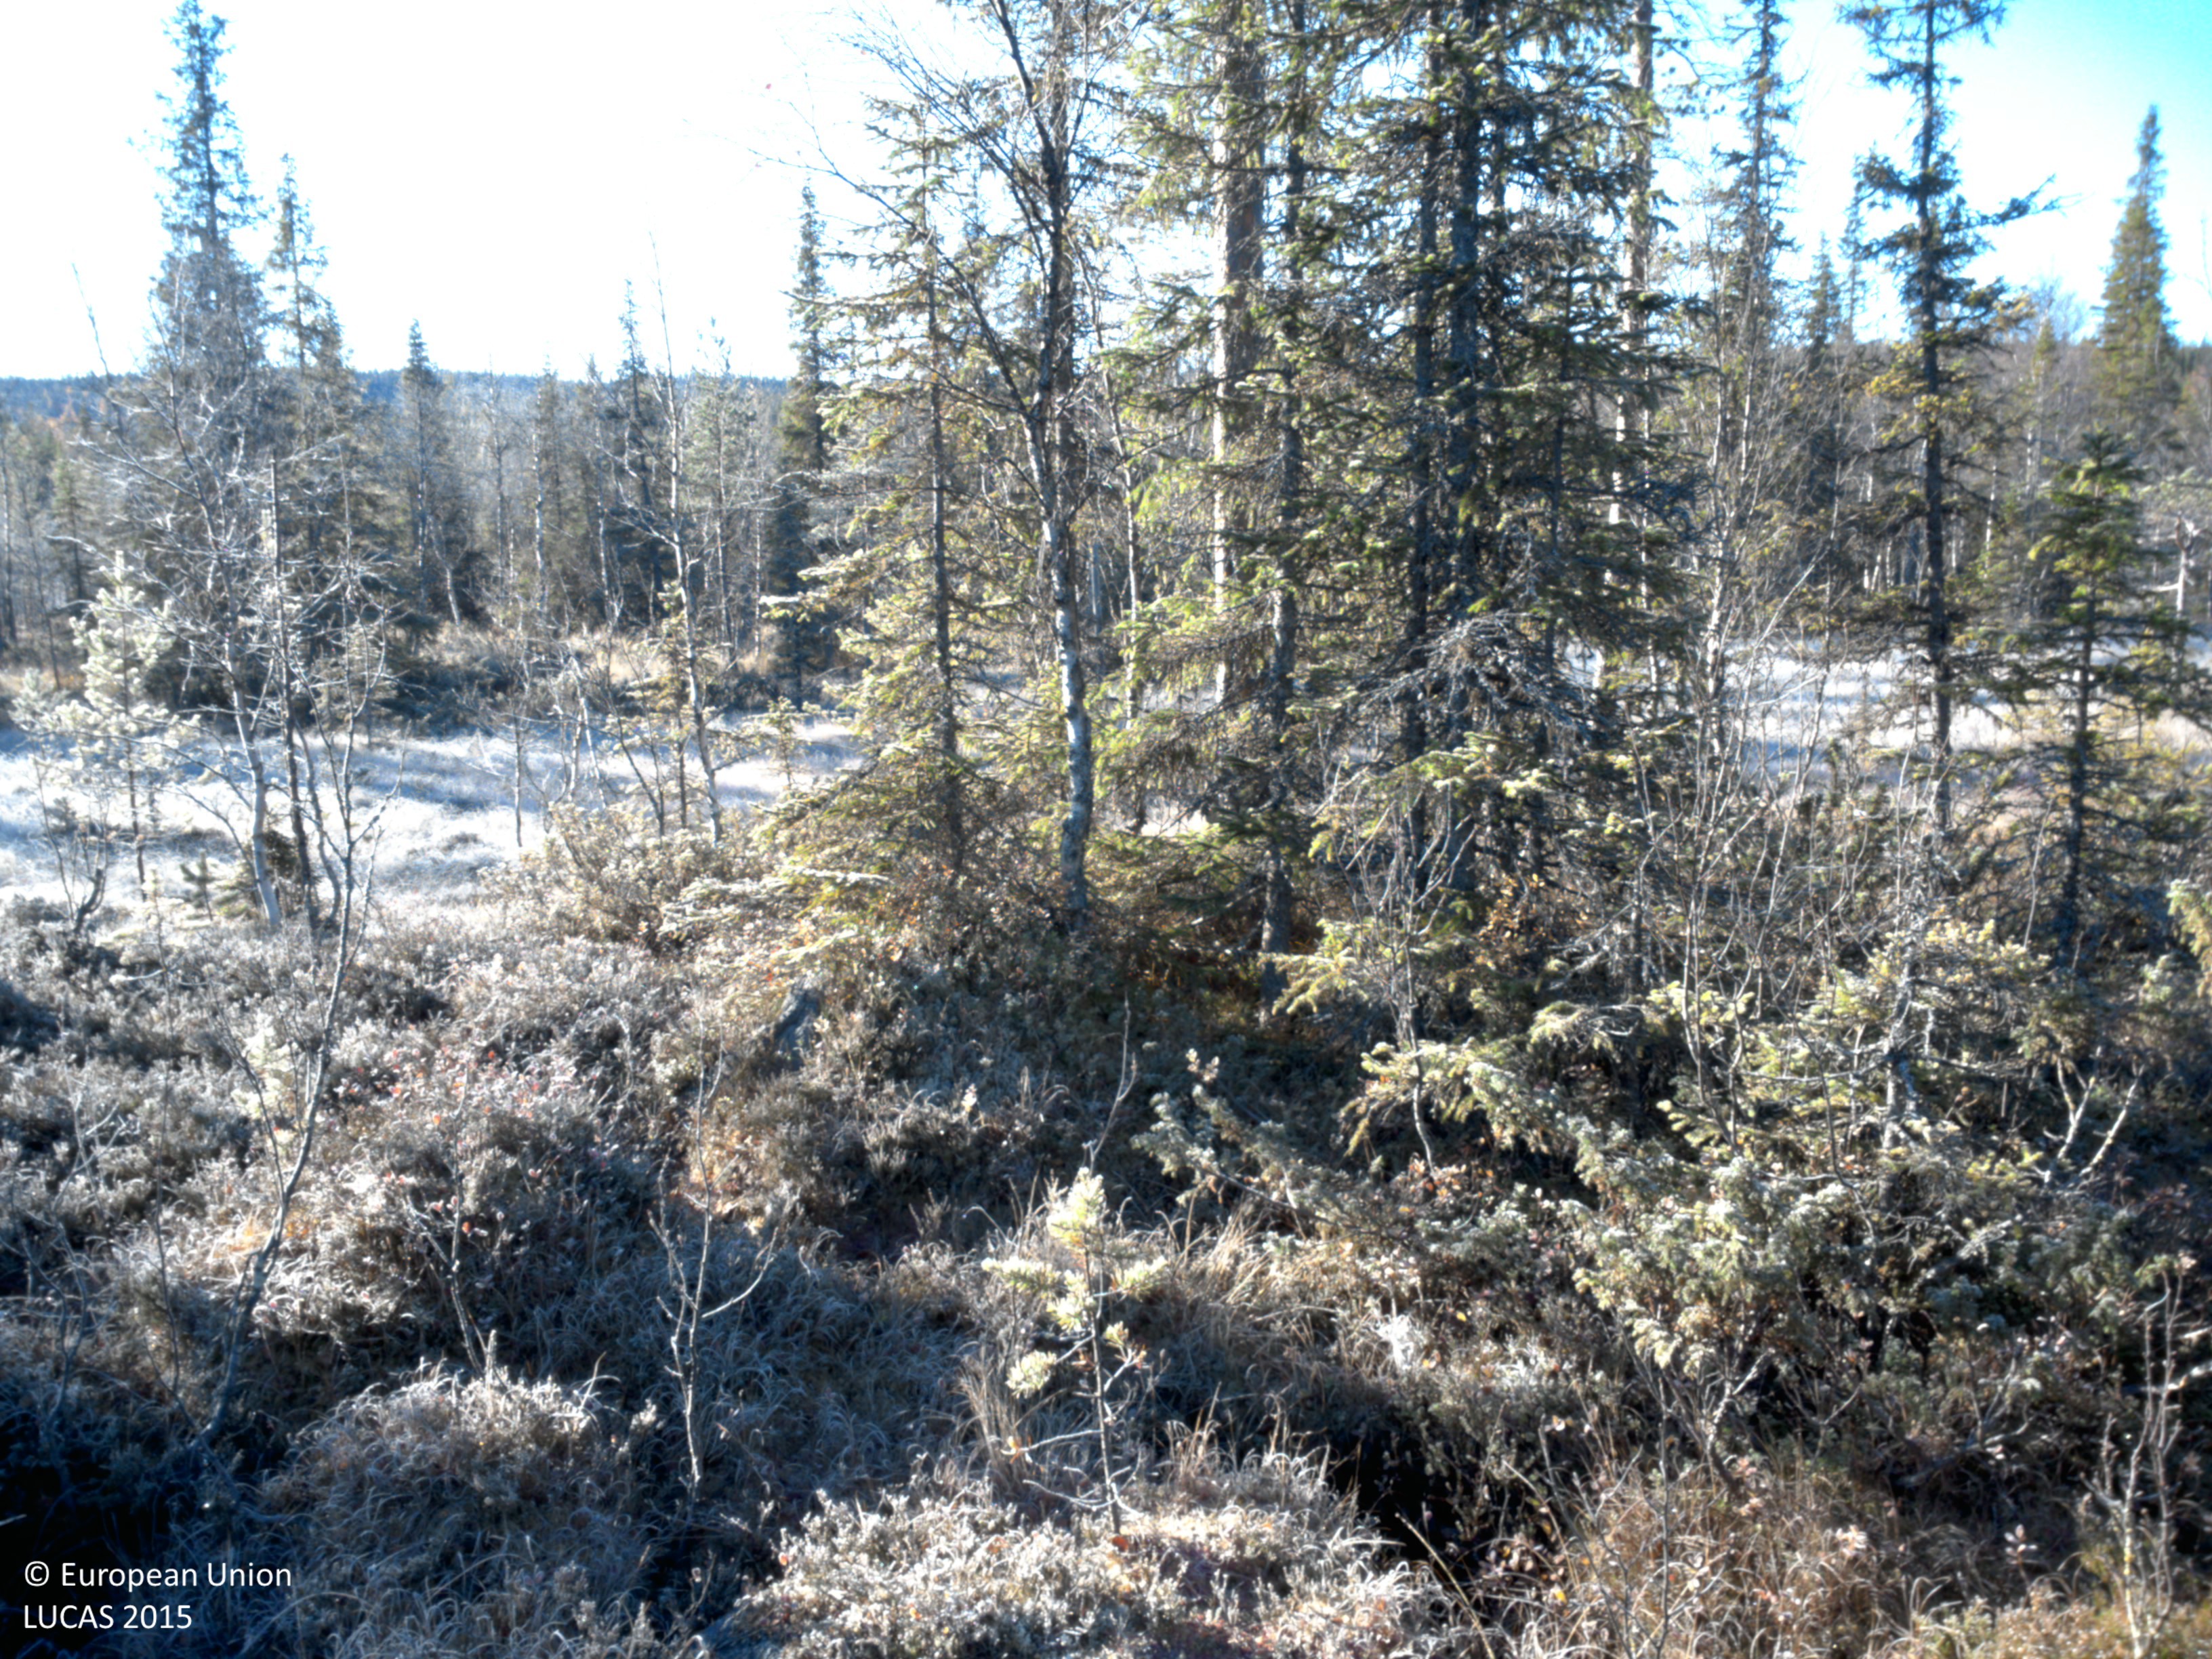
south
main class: Woodland
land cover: Spruce dominated mixed woodland
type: mire and swamp forests
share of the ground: 25 - 50 %
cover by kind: coniferous forest trees 30 %, shrubs 25 %, broadleaved forest trees 20 %, lichens and mosses 15 %, herbaceous plants 10 %
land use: Forestry
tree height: > 5 m
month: October
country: SE
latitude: 64.7530
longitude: 17.7612
